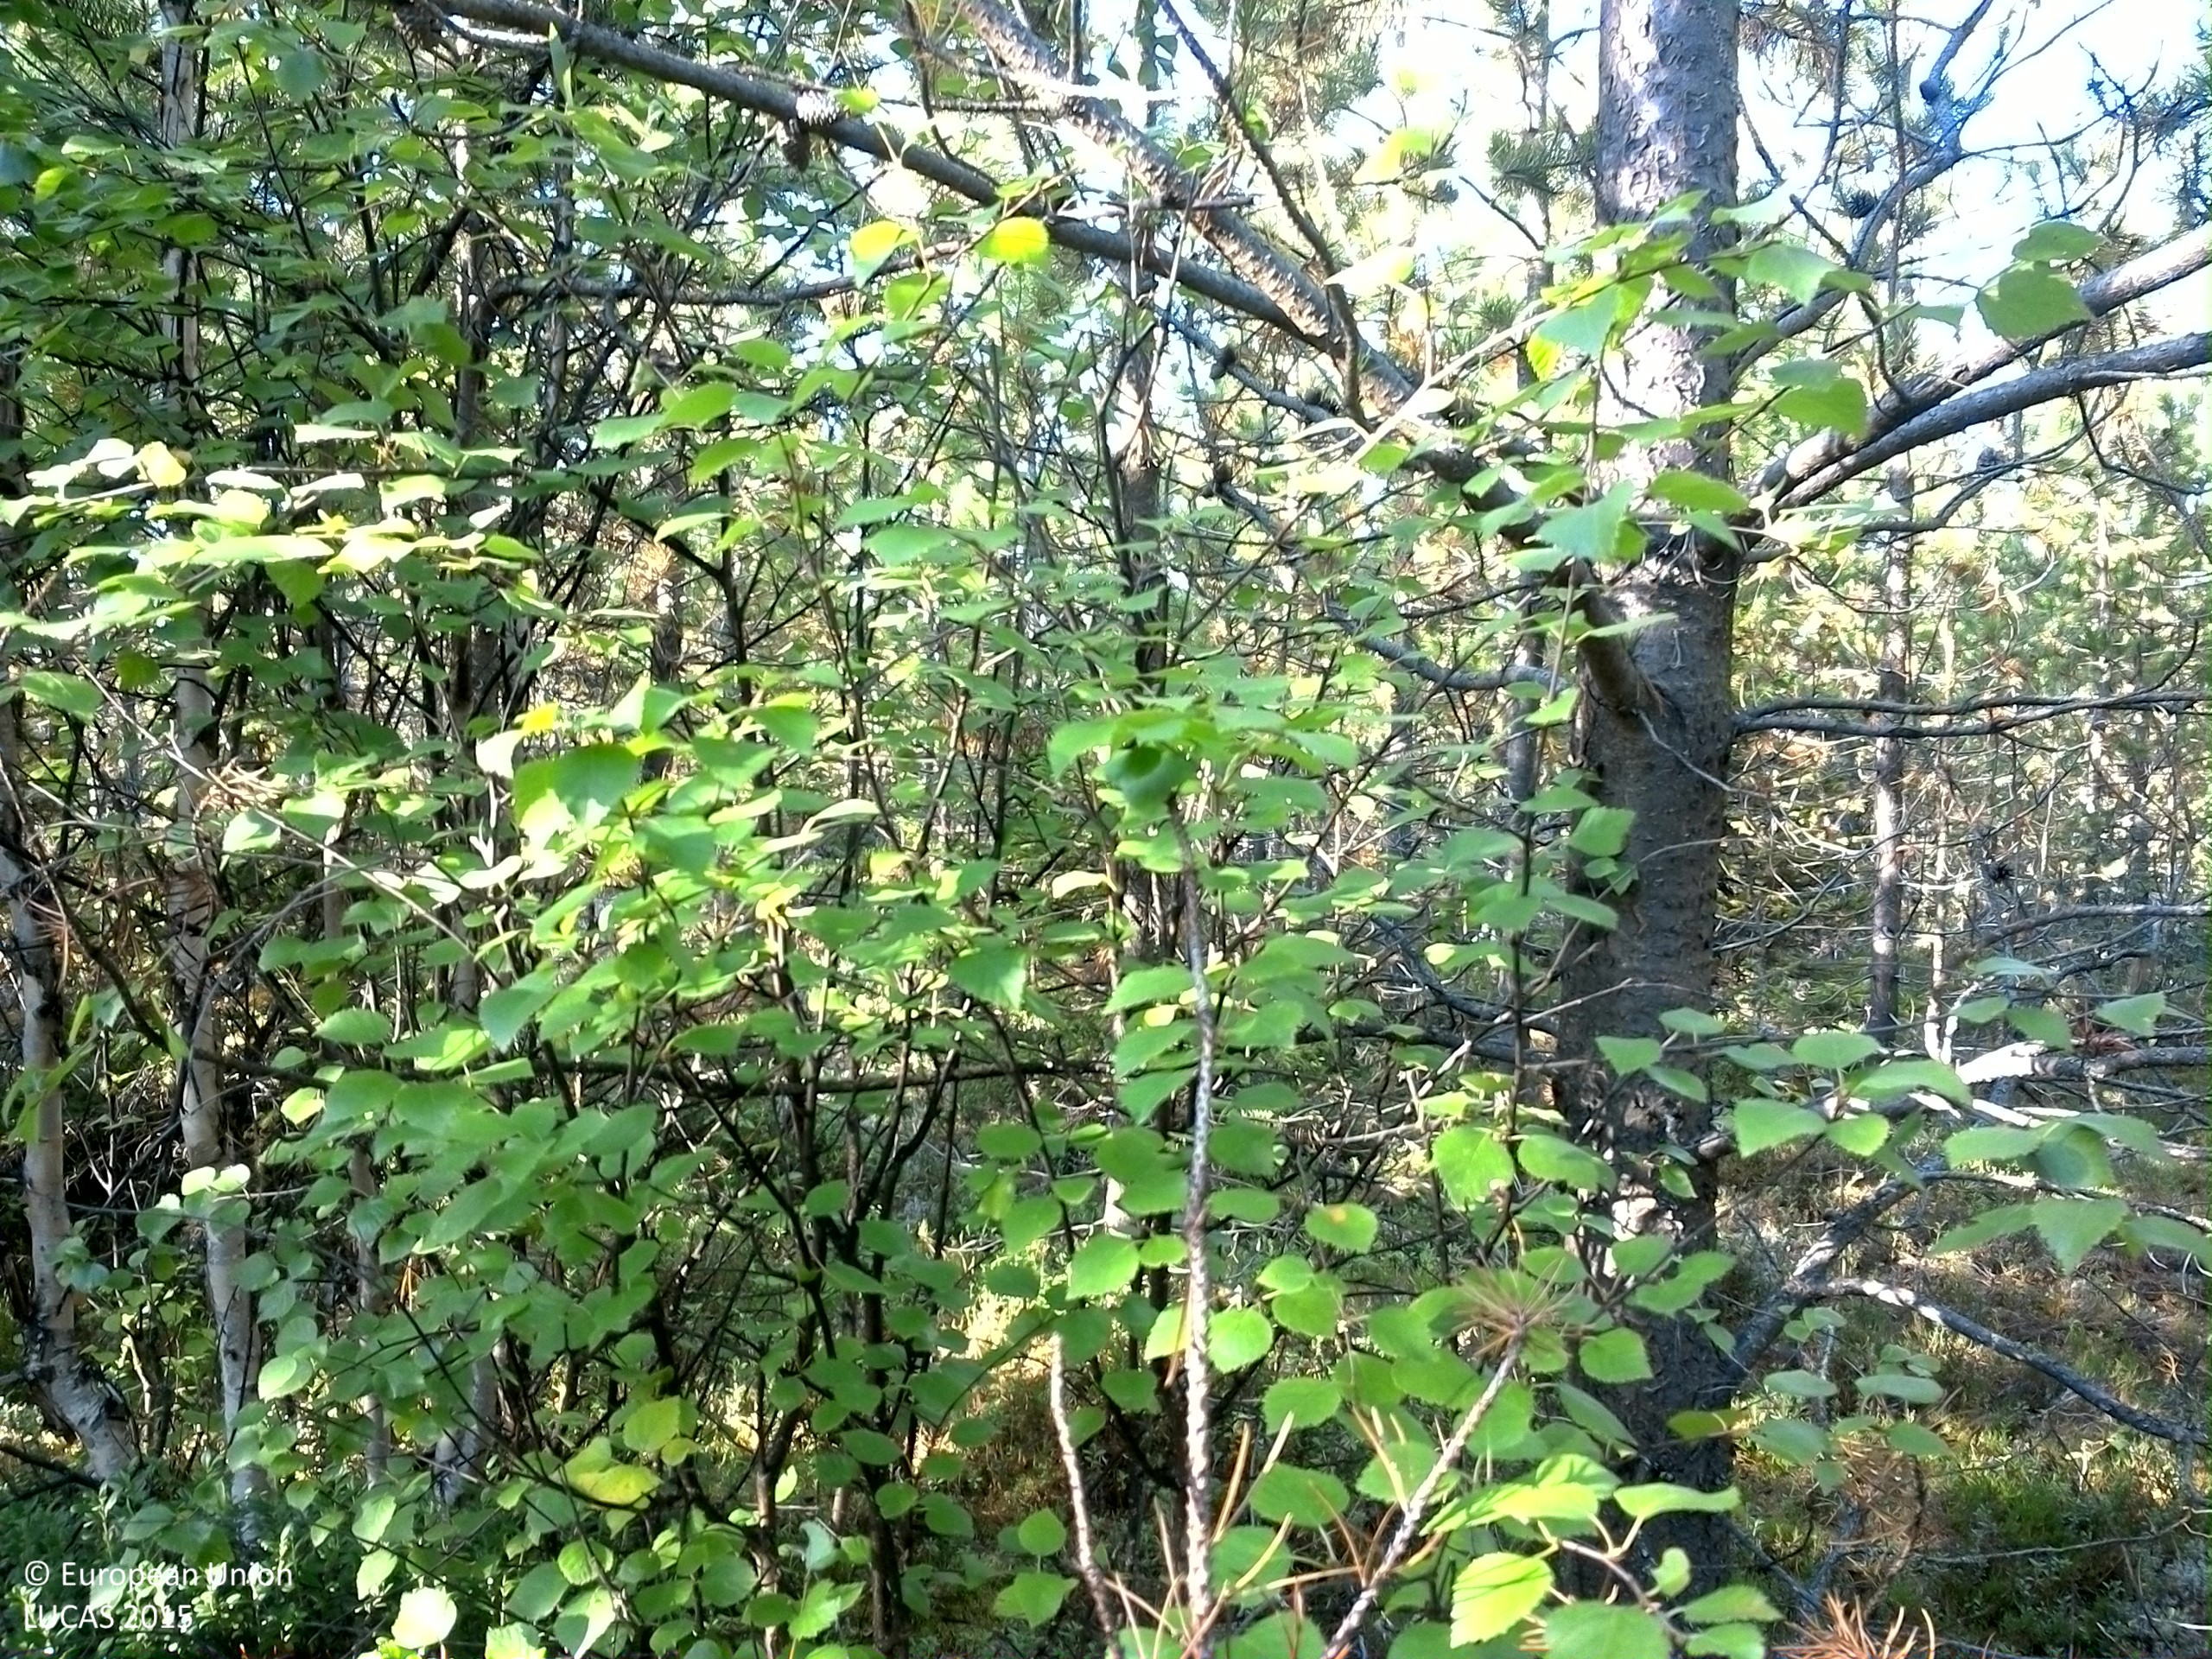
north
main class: Woodland
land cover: Pine dominated coniferous woodland
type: exotic forest
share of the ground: 50 - 75 %
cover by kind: coniferous forest trees 50 %, shrubs 25 %, lichens and mosses 15 %, broadleaved forest trees 5 %, consolidated bare surface 5 %
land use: Forestry
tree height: > 5 m
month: August
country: SE
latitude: 63.9098
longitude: 16.7578
